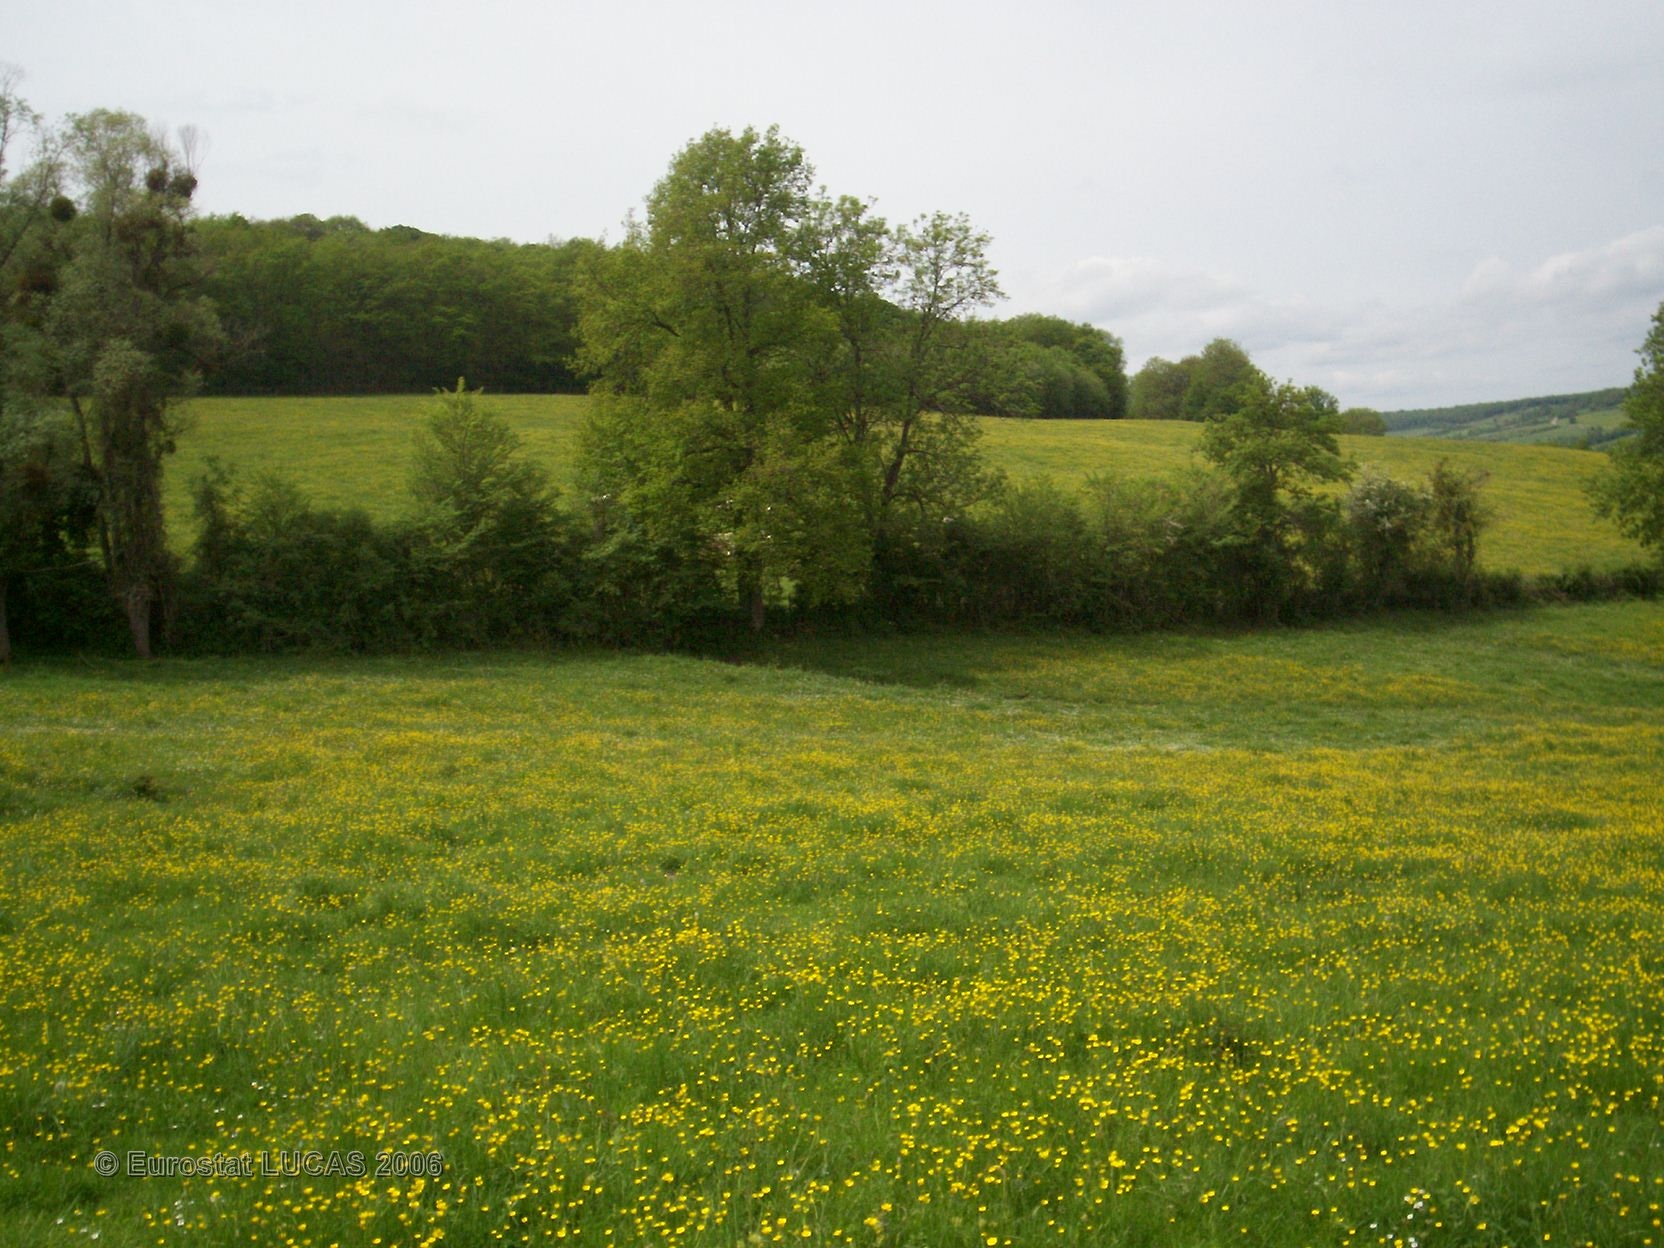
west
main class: Grassland
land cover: Grassland without tree/shrub cover
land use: Agriculture (excluding fallow land and kitchen gardens)
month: May
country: FR
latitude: 47.3137
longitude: 4.5627
